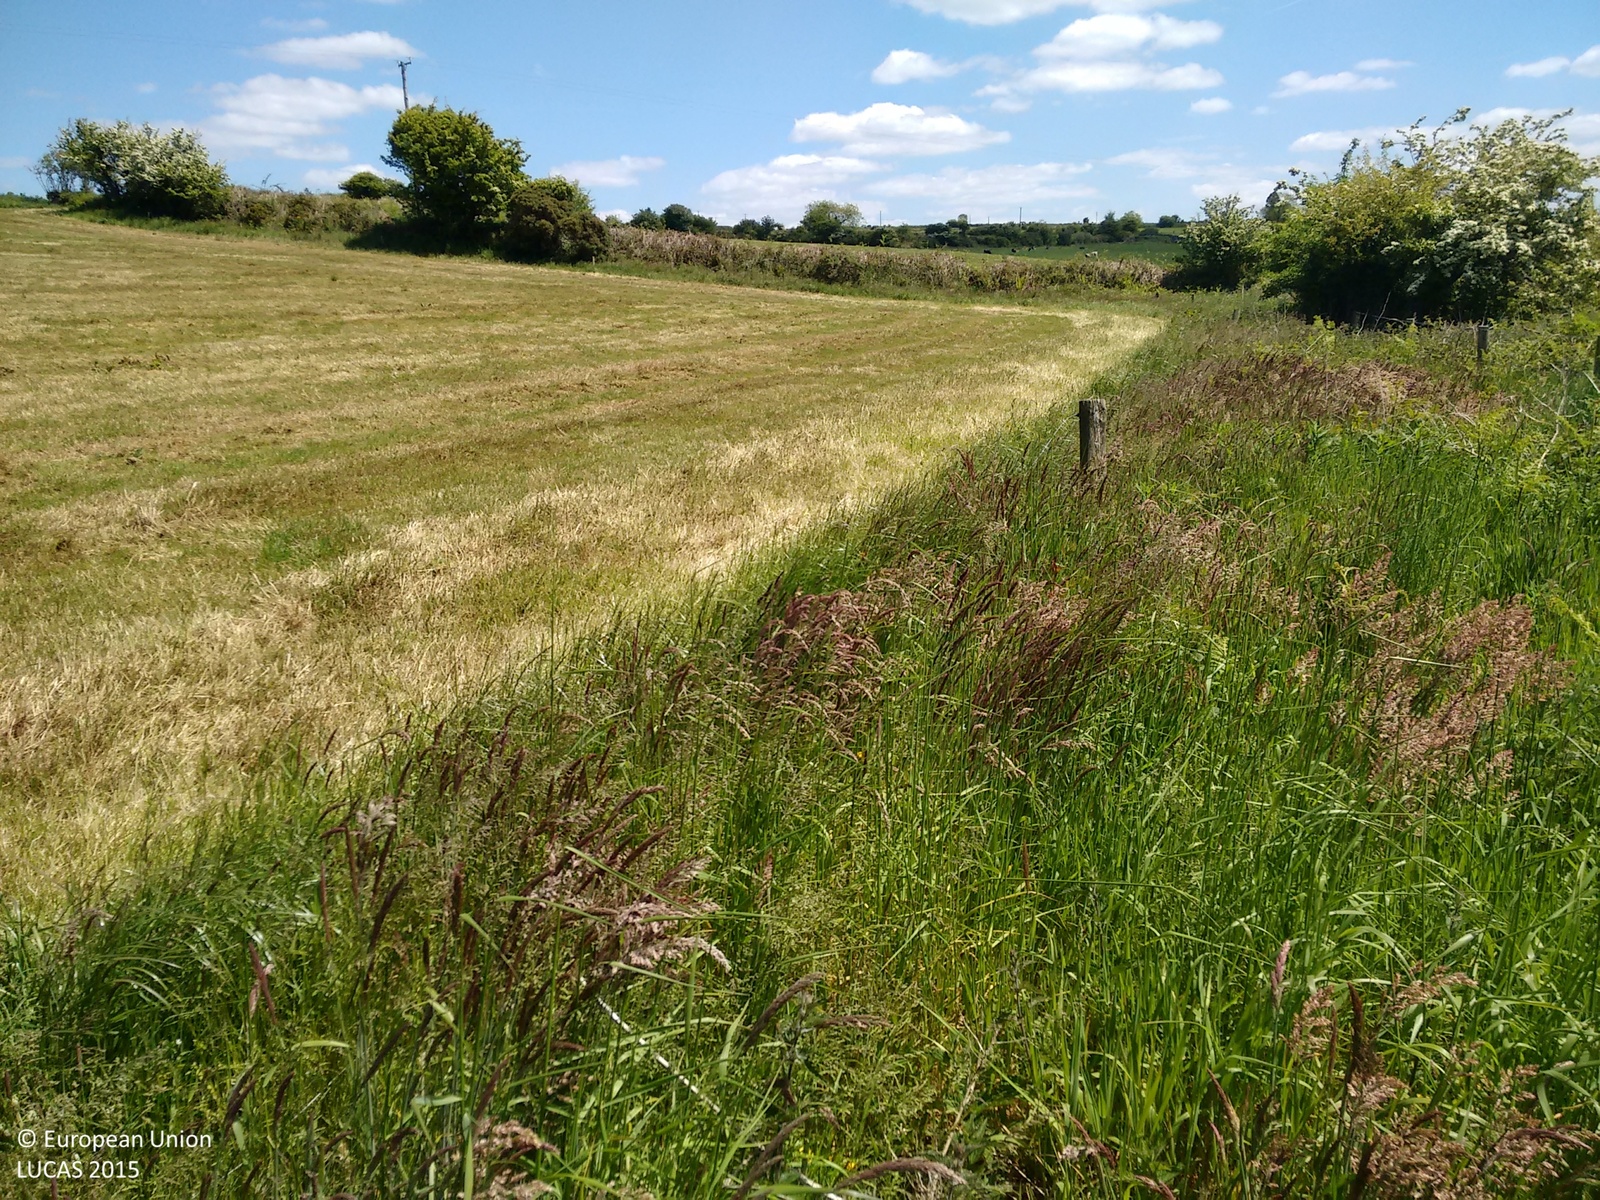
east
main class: Woodland
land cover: Broadleaved woodland
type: acidophilous oak and oak-birch forest
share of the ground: > 75 %
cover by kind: broadleaved forest trees 60 %, shrubs 20 %, herbaceous plants 20 %
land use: Forestry
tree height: < 5 m
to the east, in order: Broadleaved woodland; Shruby margins; Fences; Grass margins; Fences; Grassland without tree/shrub cover; Fences; Abandoned hedges; Fences; Grassland without tree/shrub cover; Electric lines; Grassland without tree/shrub cover; Fences; Abandoned hedges; Fences; Grassland without tree/shrub cover
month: June
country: IE
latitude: 52.0003
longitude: -8.8062
